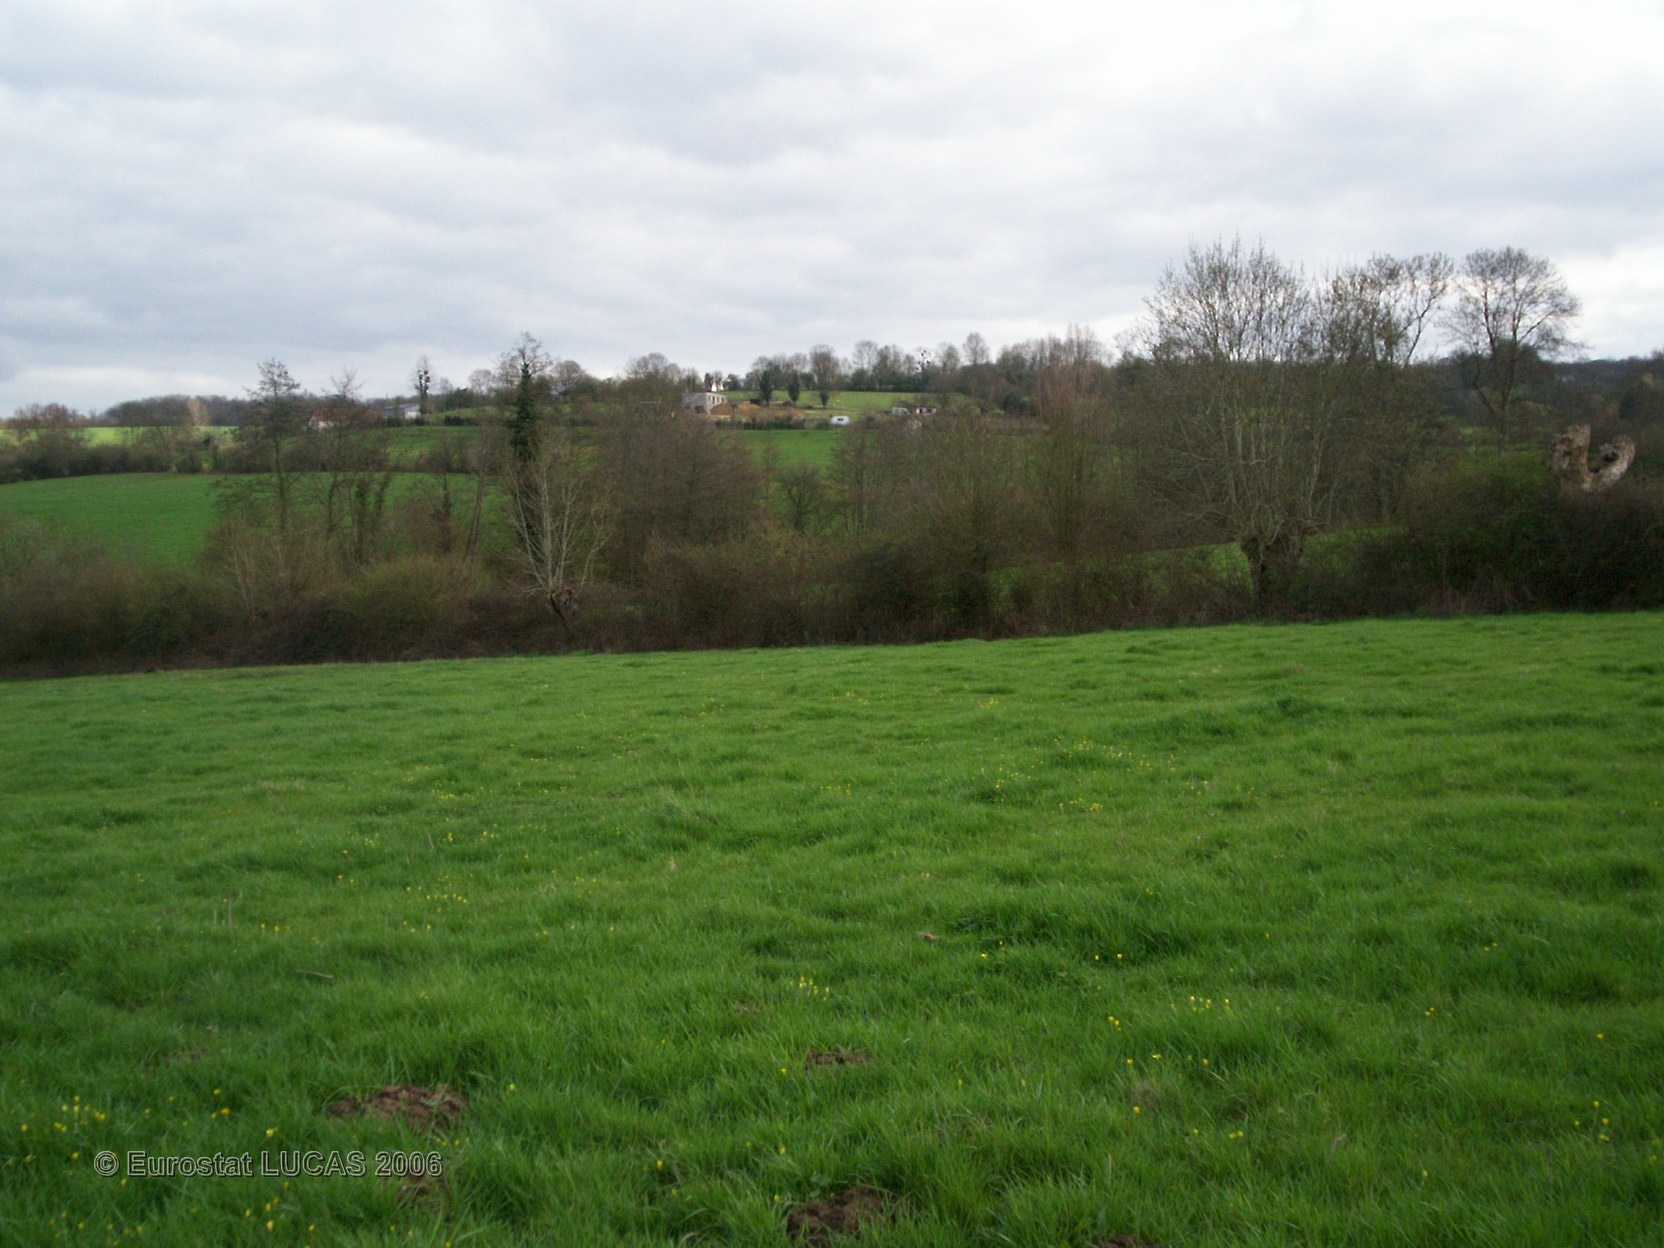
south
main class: Grassland
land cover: Grassland without tree/shrub cover
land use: Agriculture (excluding fallow land and kitchen gardens)
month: April
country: FR
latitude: 48.8989
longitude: 0.0804
